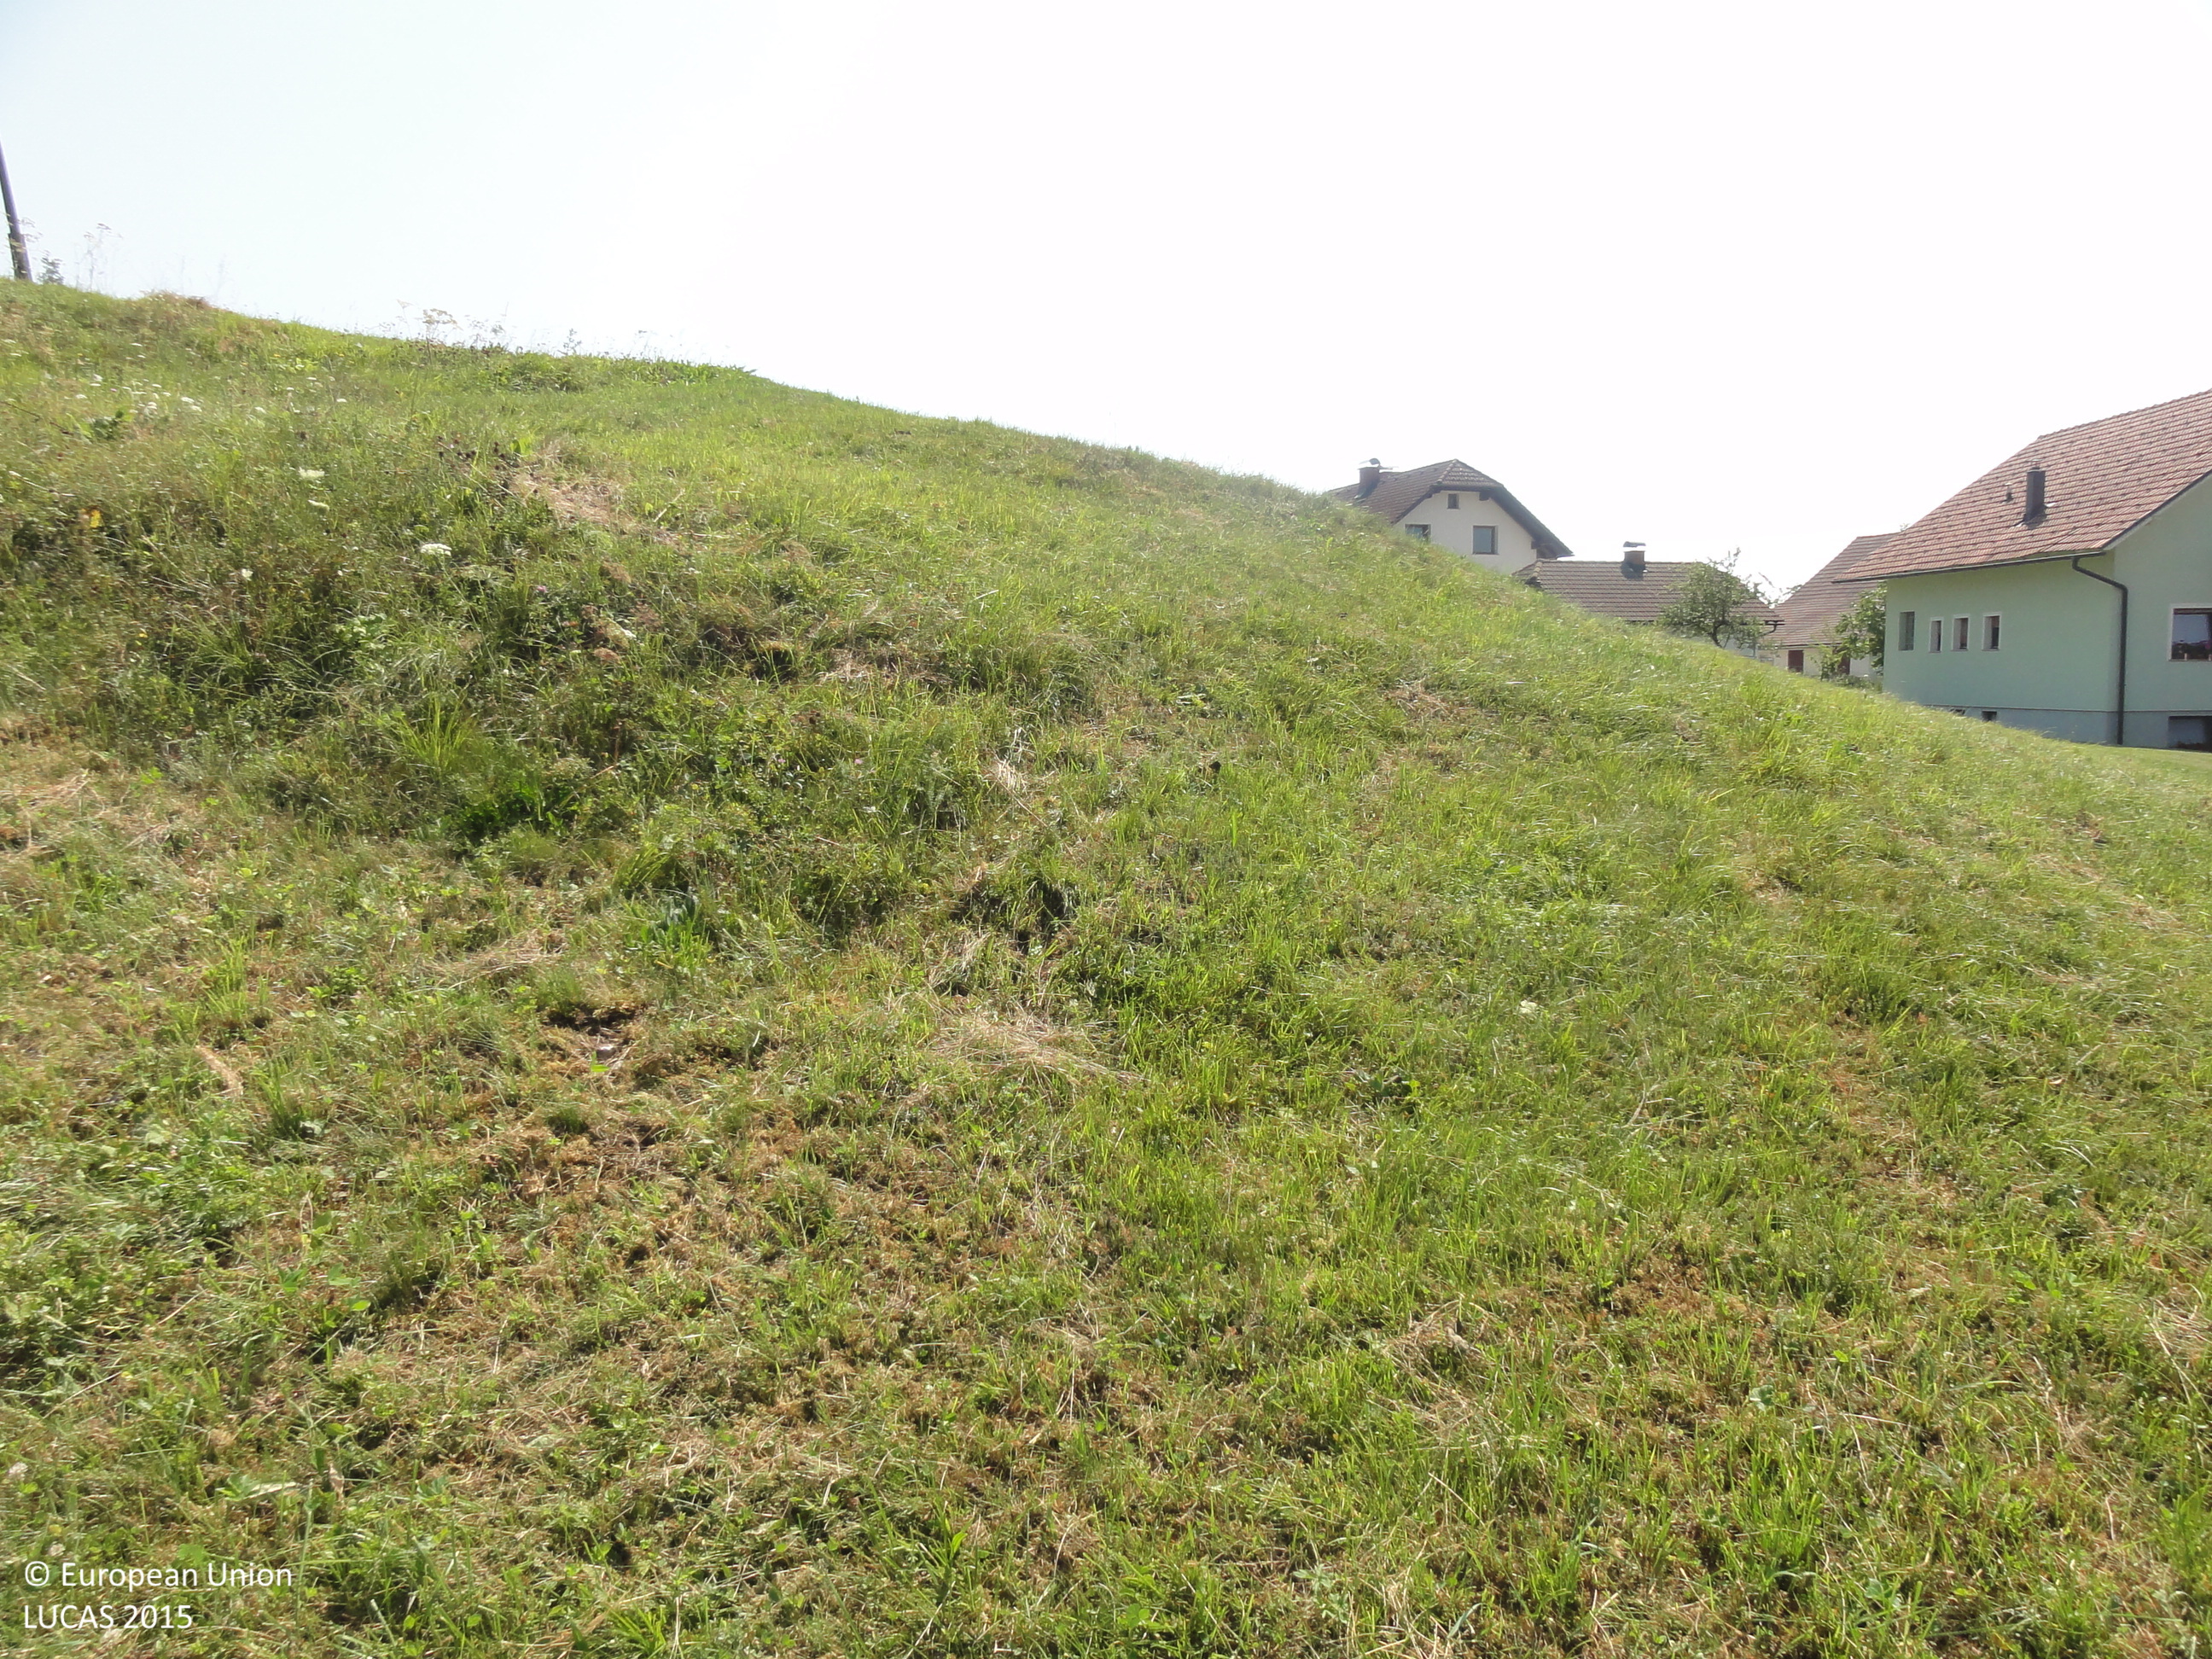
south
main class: Grassland
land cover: Grassland without tree/shrub cover
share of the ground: > 75 %
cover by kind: herbaceous plants 100 %
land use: Agriculture (excluding fallow land and kitchen gardens)
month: August
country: SI
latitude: 46.0347
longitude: 15.0230
